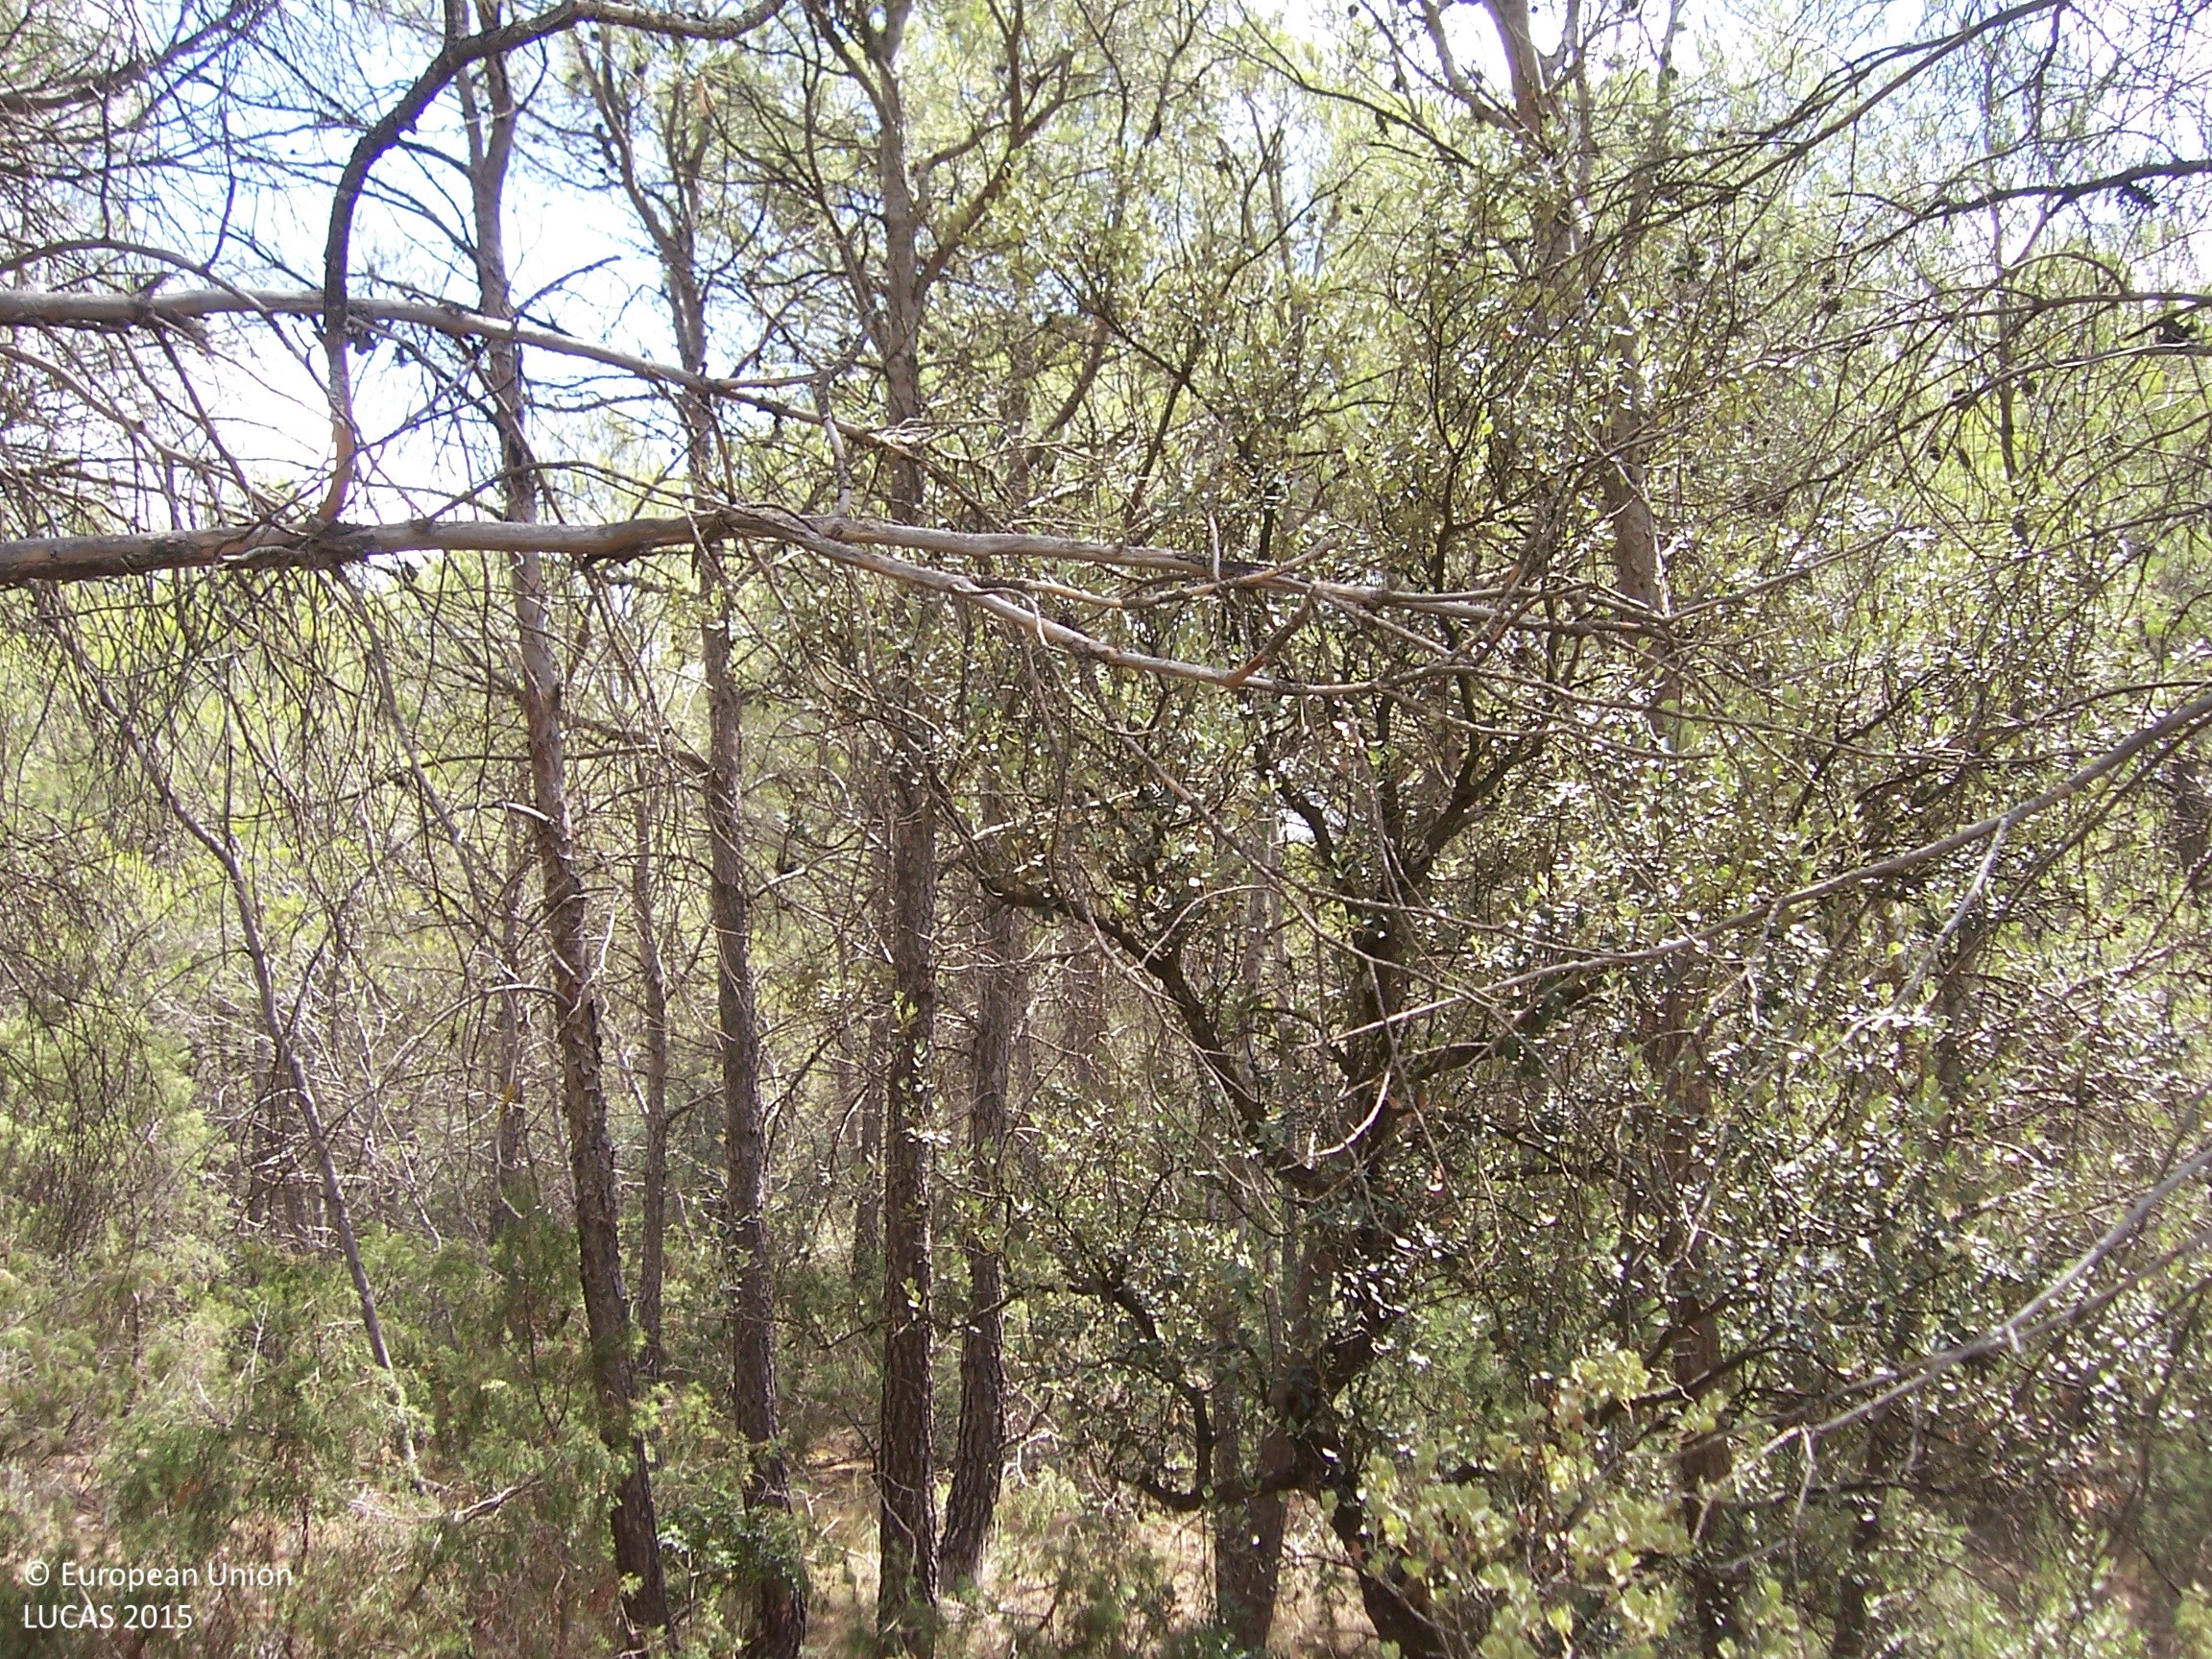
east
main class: Woodland
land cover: Pine dominated mixed woodland
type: coniferous forest of the mediterranean region
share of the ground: > 75 %
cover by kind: coniferous forest trees 50 %, broadleaved forest trees 20 %, shrubs 20 %, herbaceous plants 5 %, unconsolidated bare surface 5 %
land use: Semi-natural and natural areas not in use
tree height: > 5 m
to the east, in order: Pine dominated mixed woodland; Tracks; Pine dominated mixed woodland
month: August
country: ES
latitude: 41.9177
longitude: 0.5199
